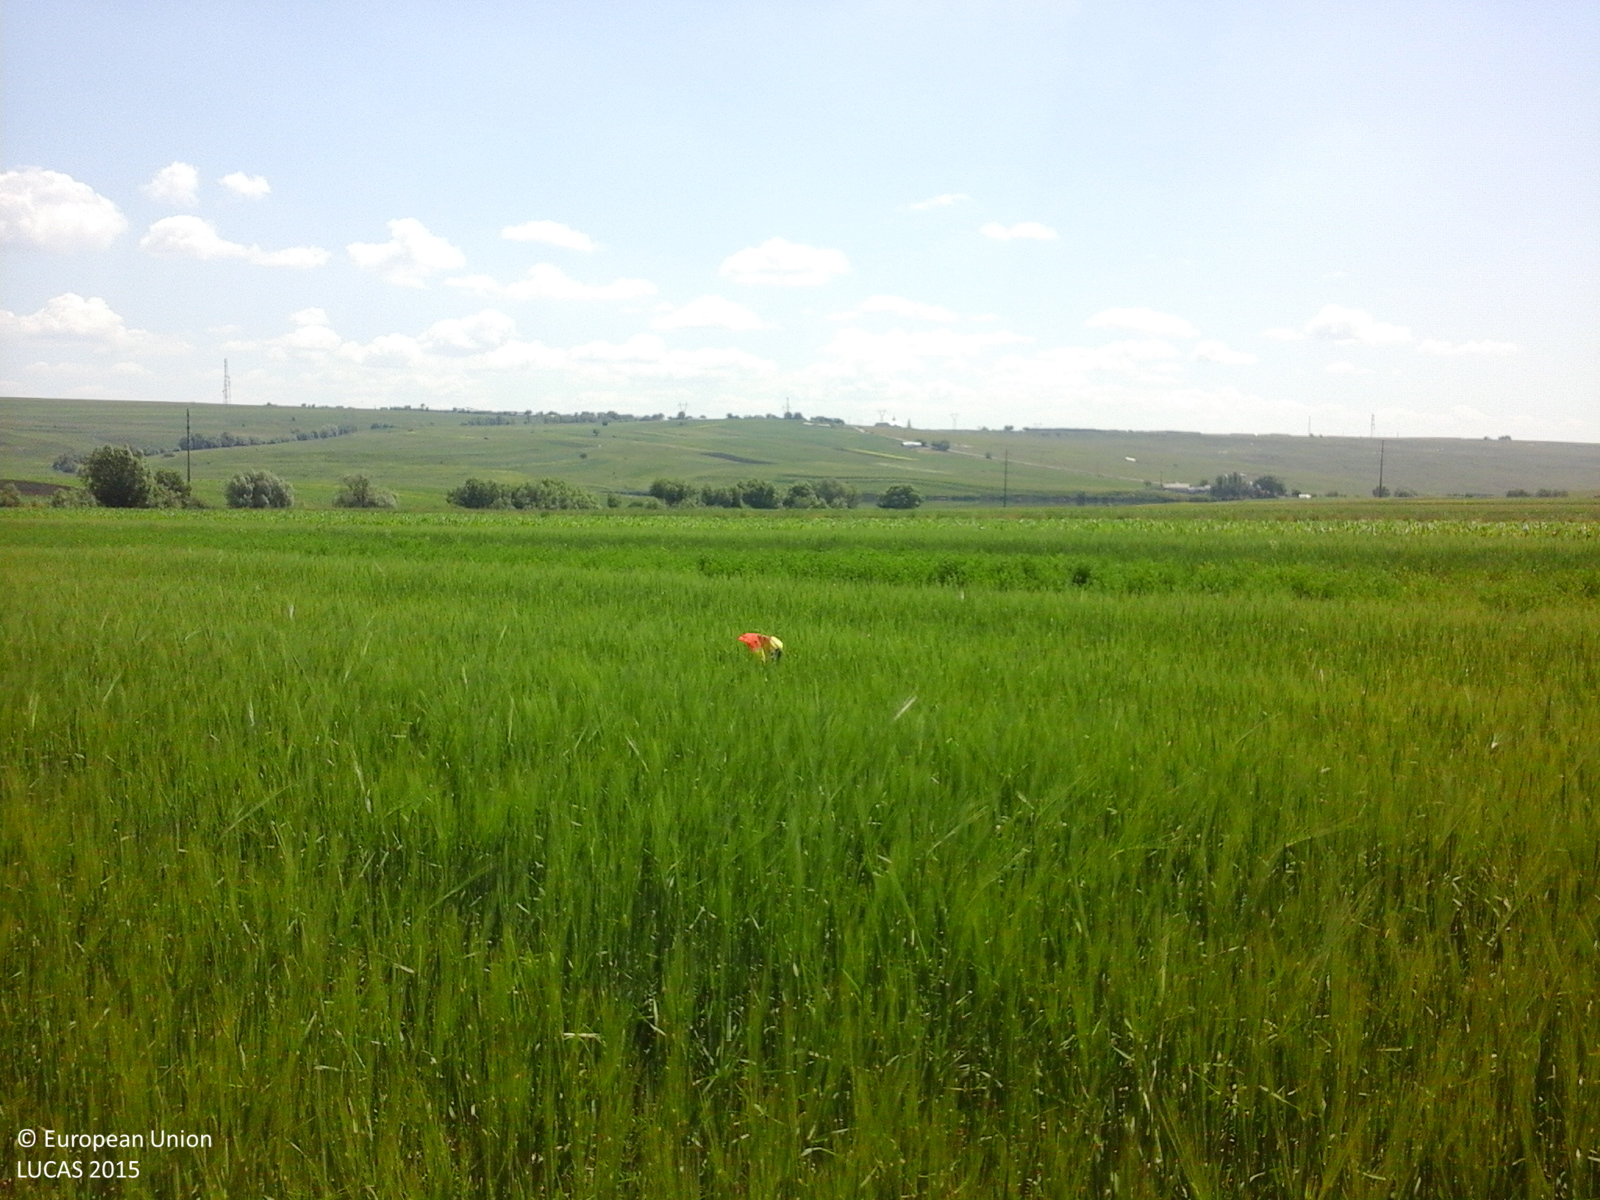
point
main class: Cropland
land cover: Barley
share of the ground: > 75 %
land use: Agriculture (excluding fallow land and kitchen gardens)
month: June
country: RO
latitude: 47.5918
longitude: 26.2672
